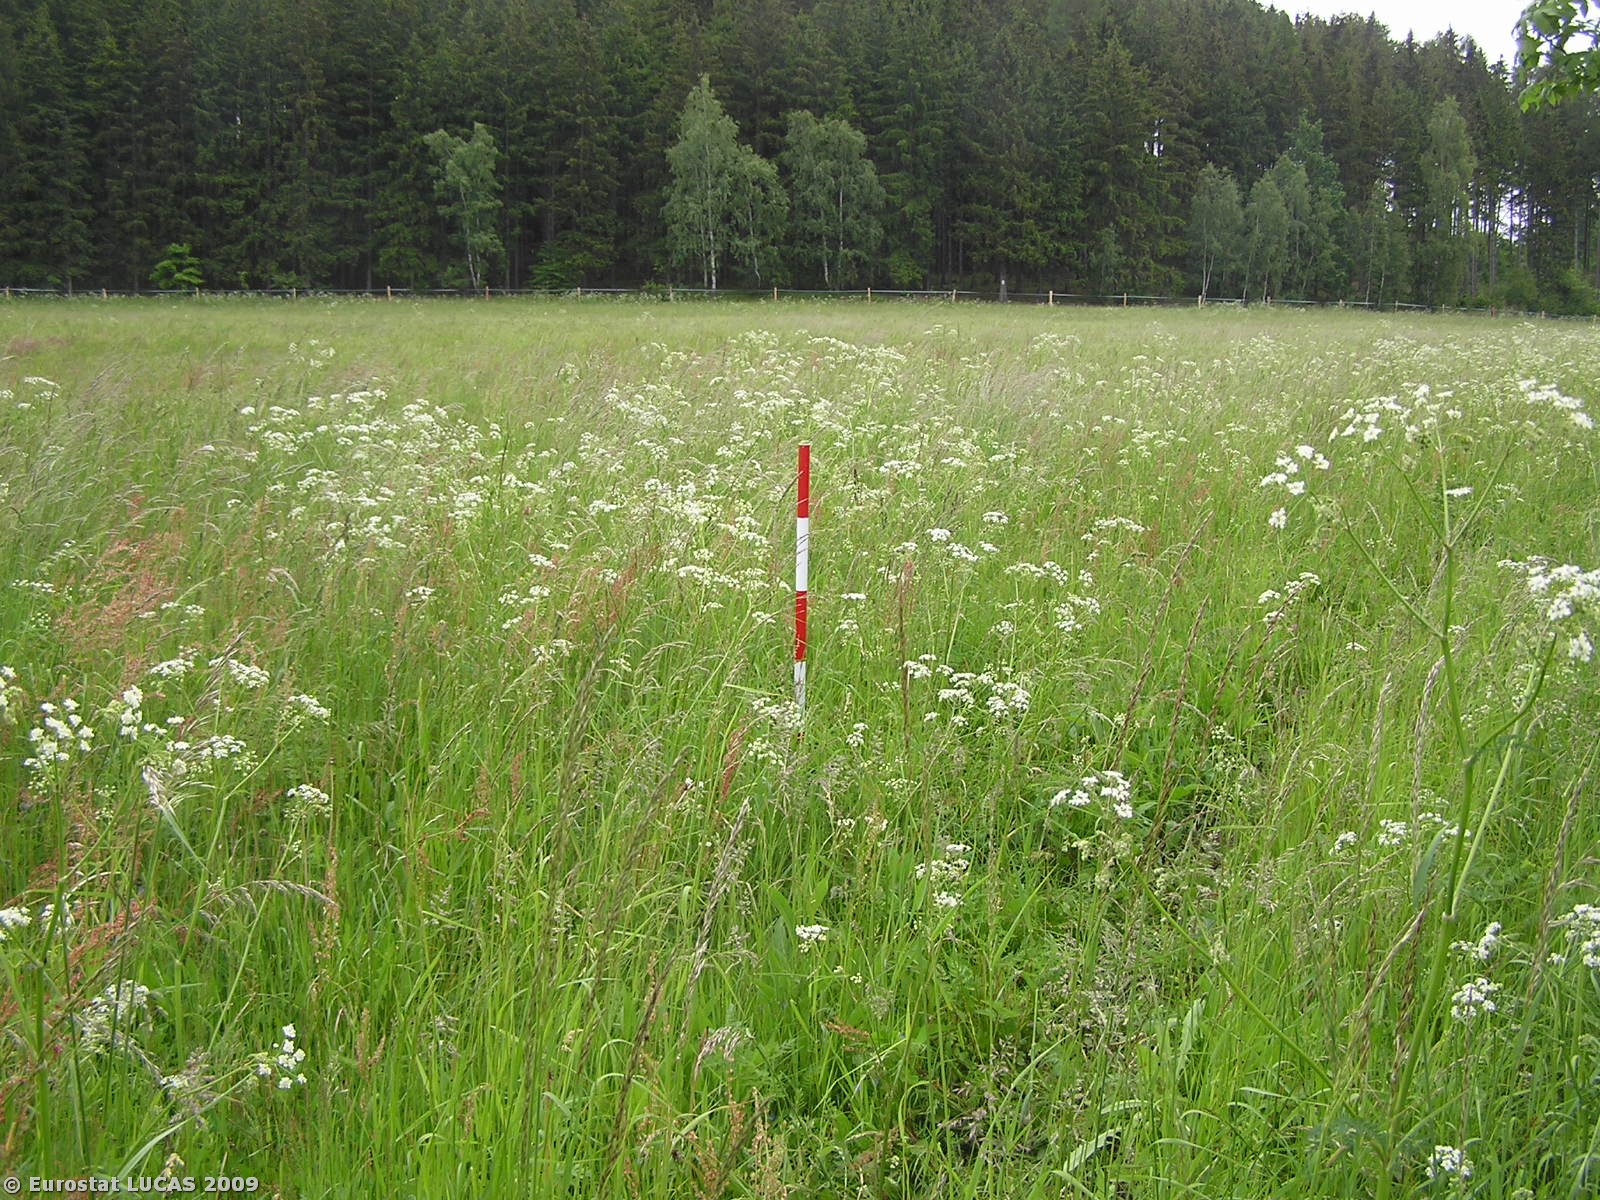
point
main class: Grassland
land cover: Grassland without tree/shrub cover
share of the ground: > 75 %
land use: Agriculture (excluding fallow land and kitchen gardens)
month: June
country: CZ
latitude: 50.0644
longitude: 17.4862
